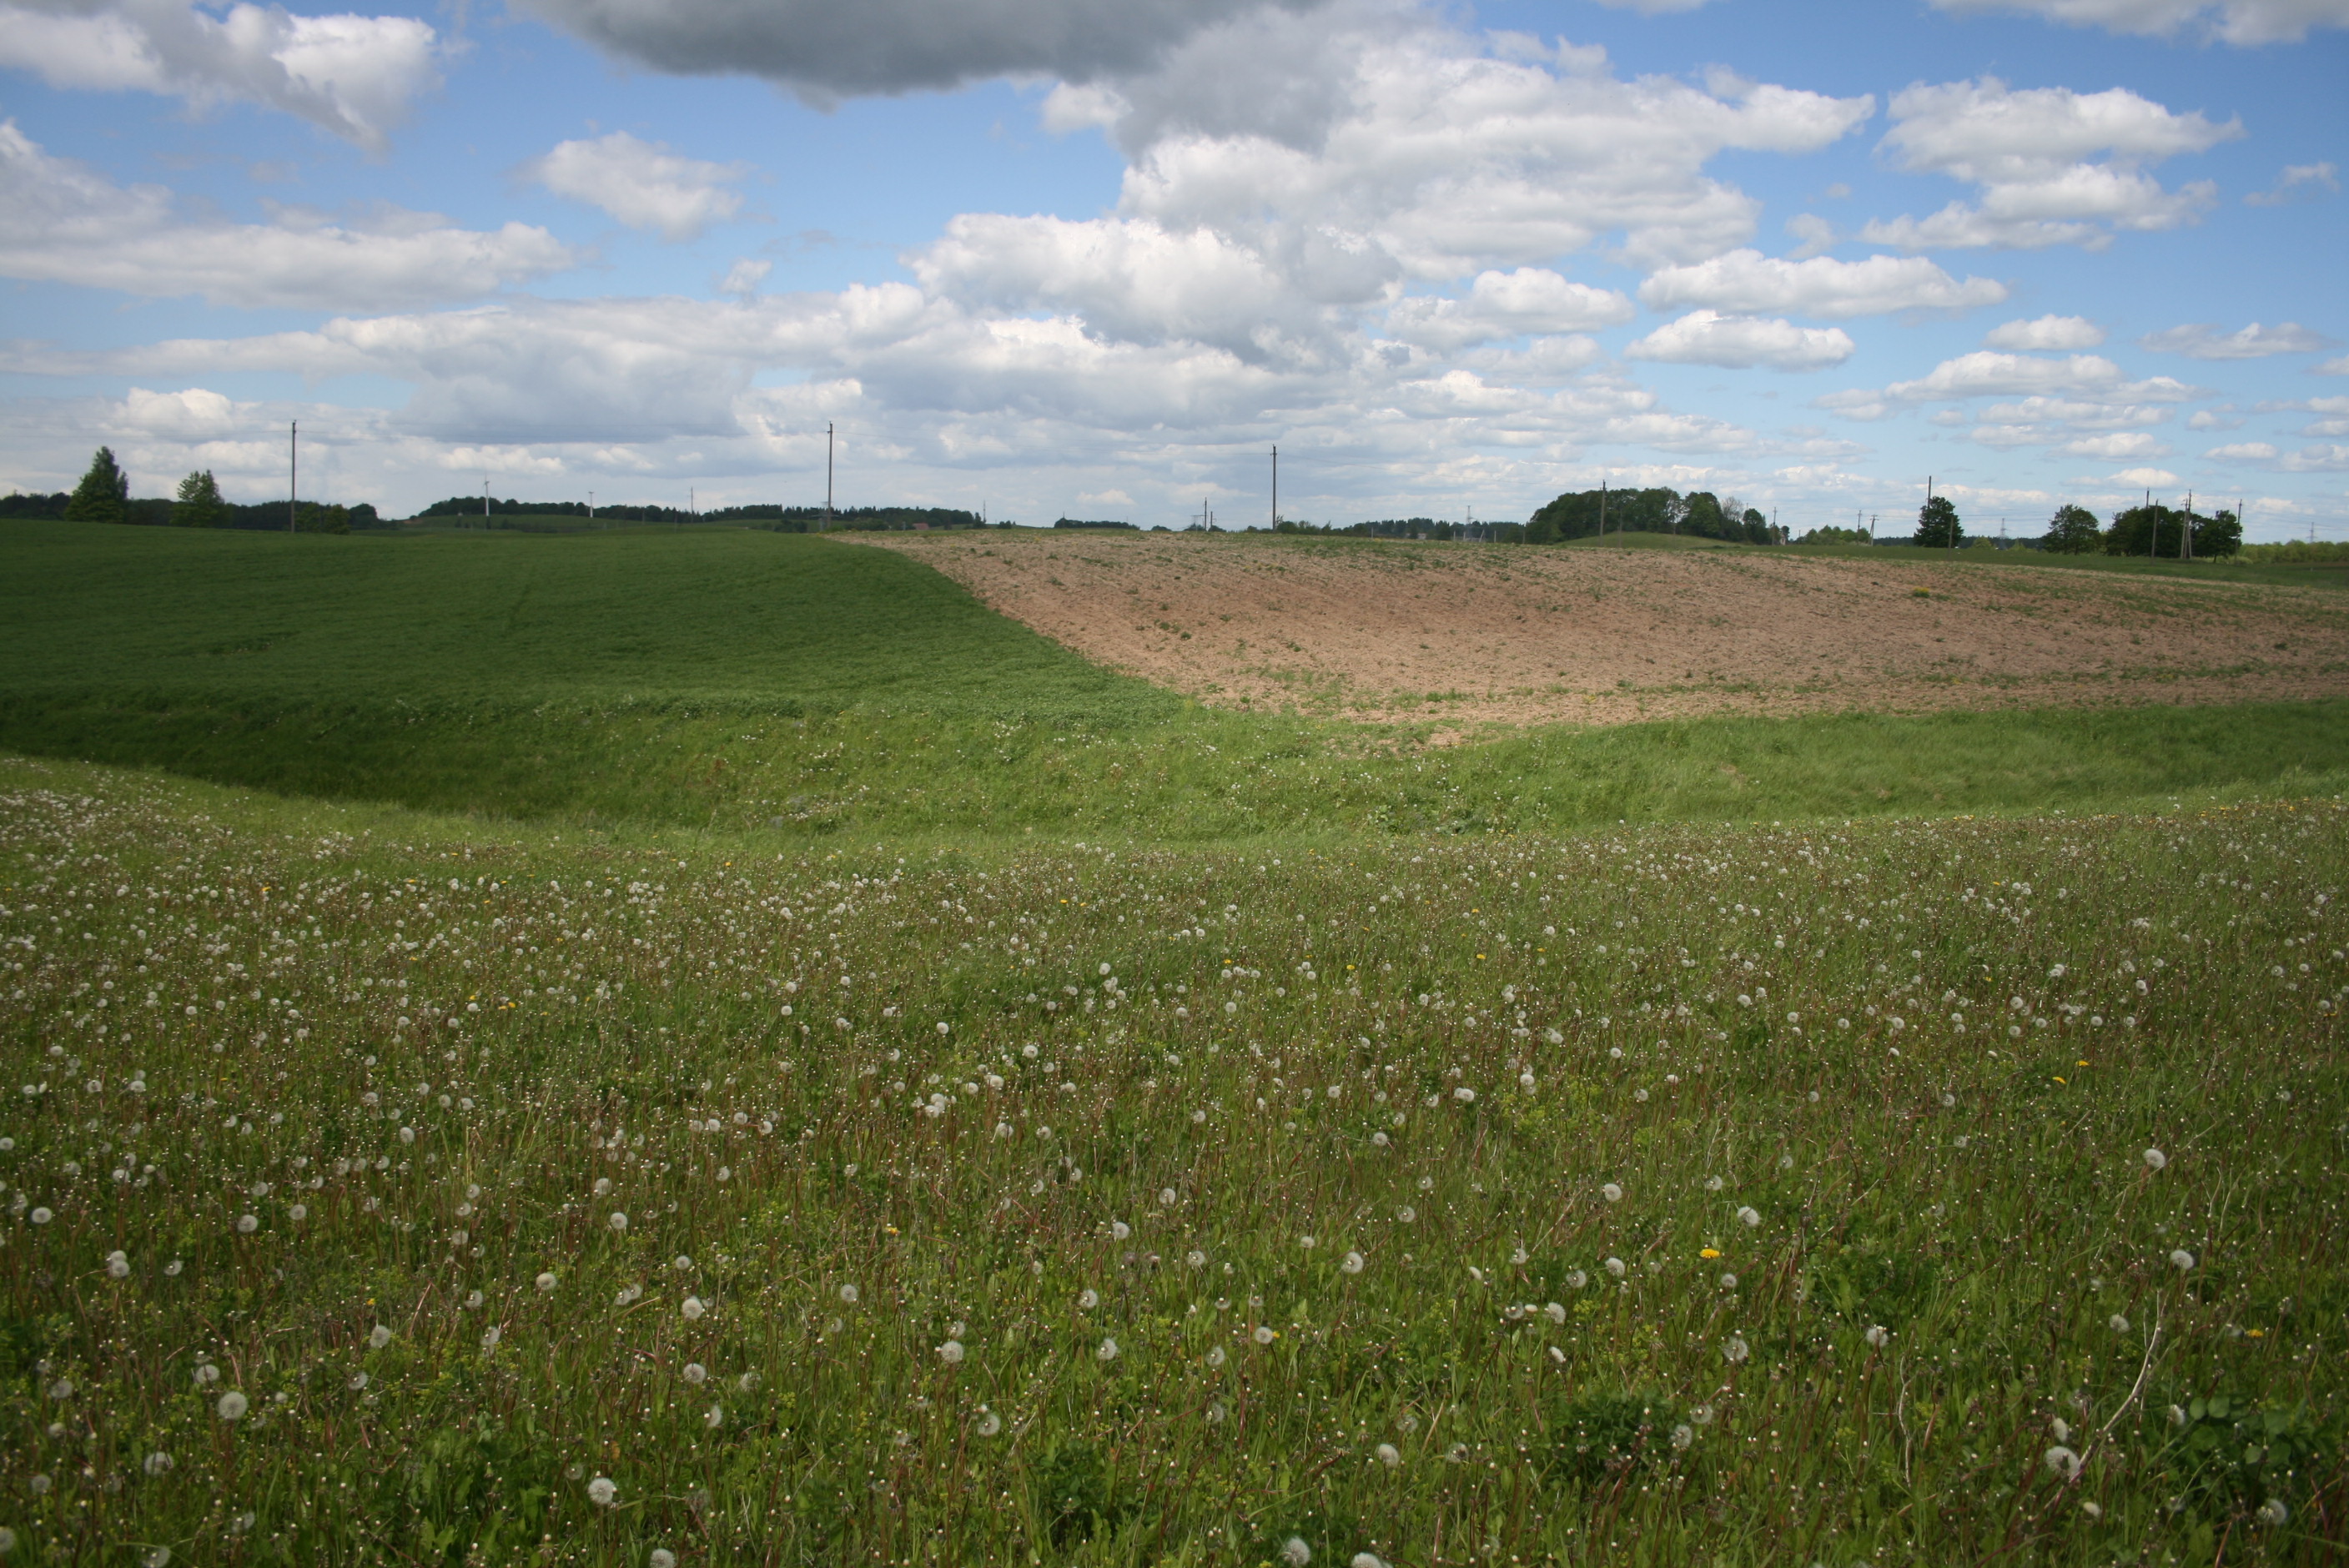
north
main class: Grassland
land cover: Grassland without tree/shrub cover
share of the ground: > 75 %
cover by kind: herbaceous plants 100 %
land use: Agriculture (excluding fallow land and kitchen gardens)
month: May
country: LT
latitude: 56.0011
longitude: 22.2255
